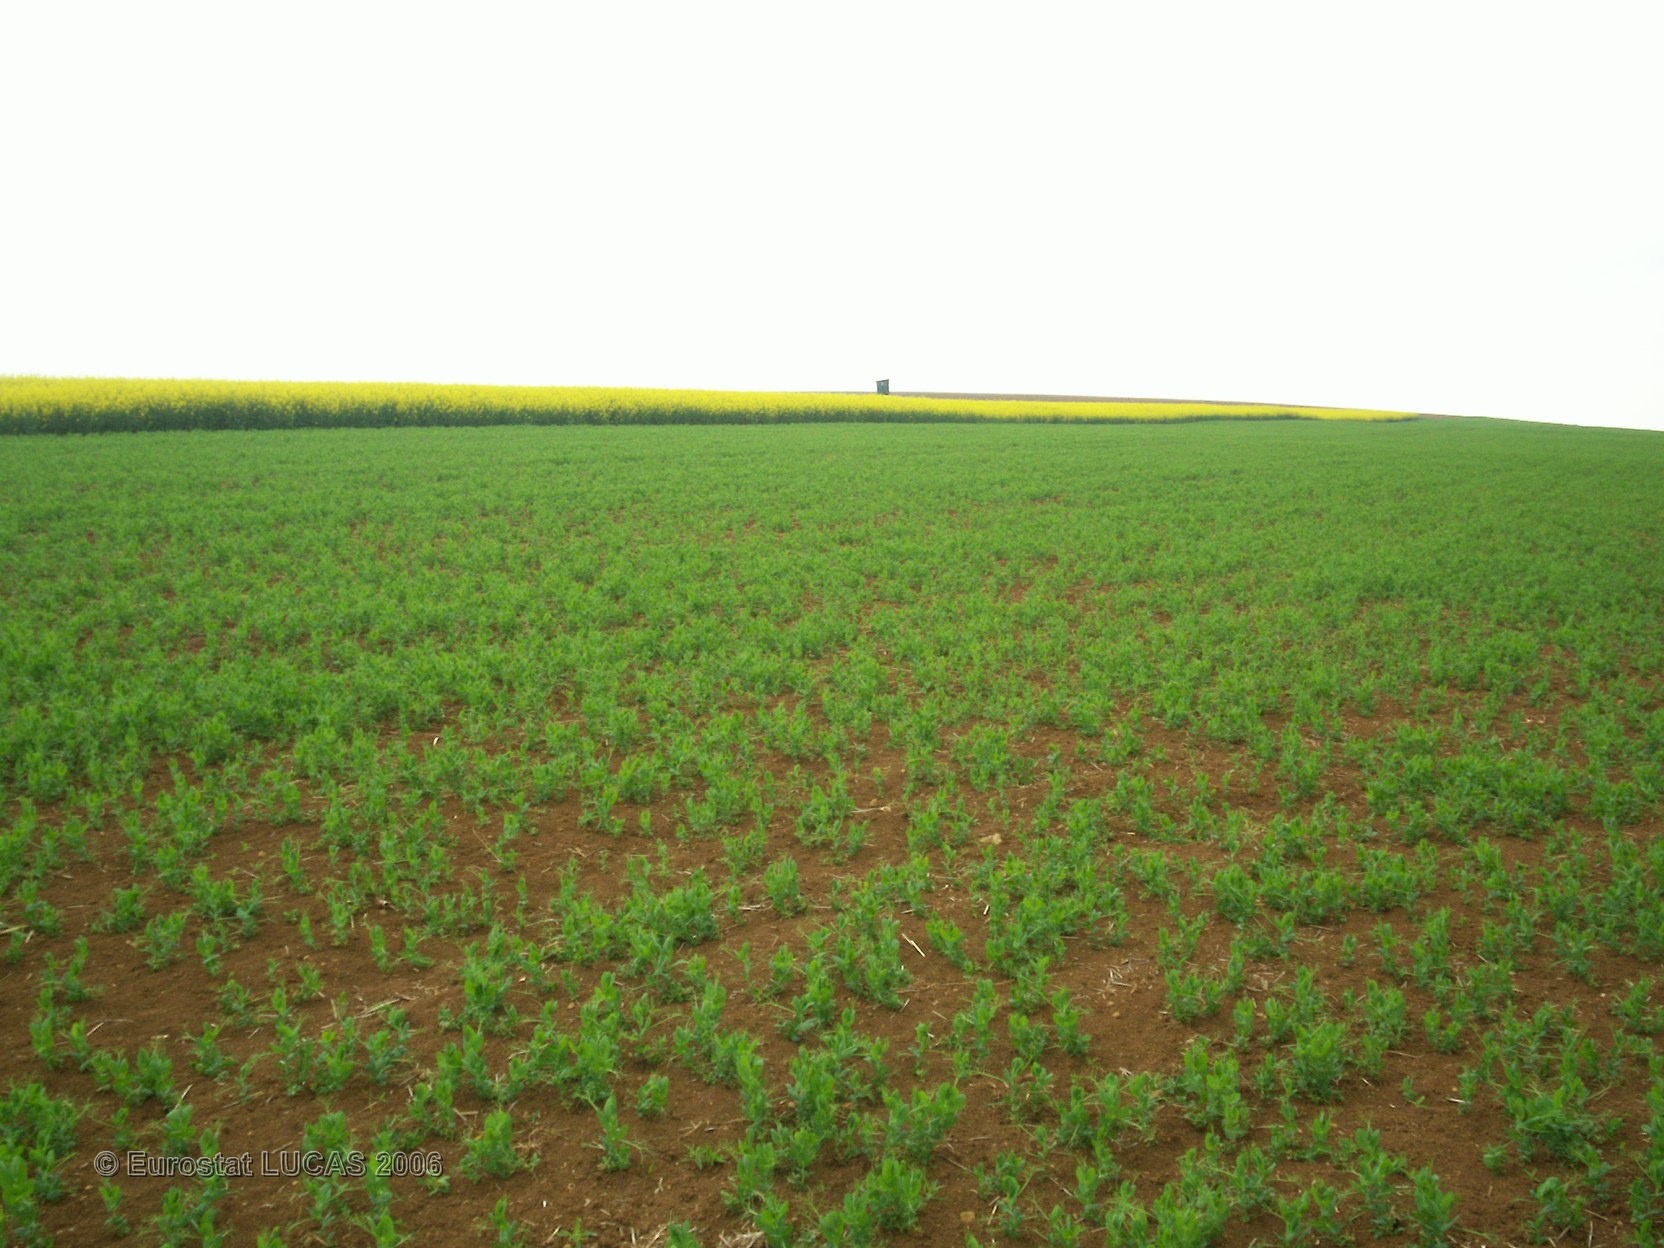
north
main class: Cropland
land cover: Dry pulses
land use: Agriculture (excluding fallow land and kitchen gardens)
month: May
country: FR
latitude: 49.4254
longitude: 6.4014
